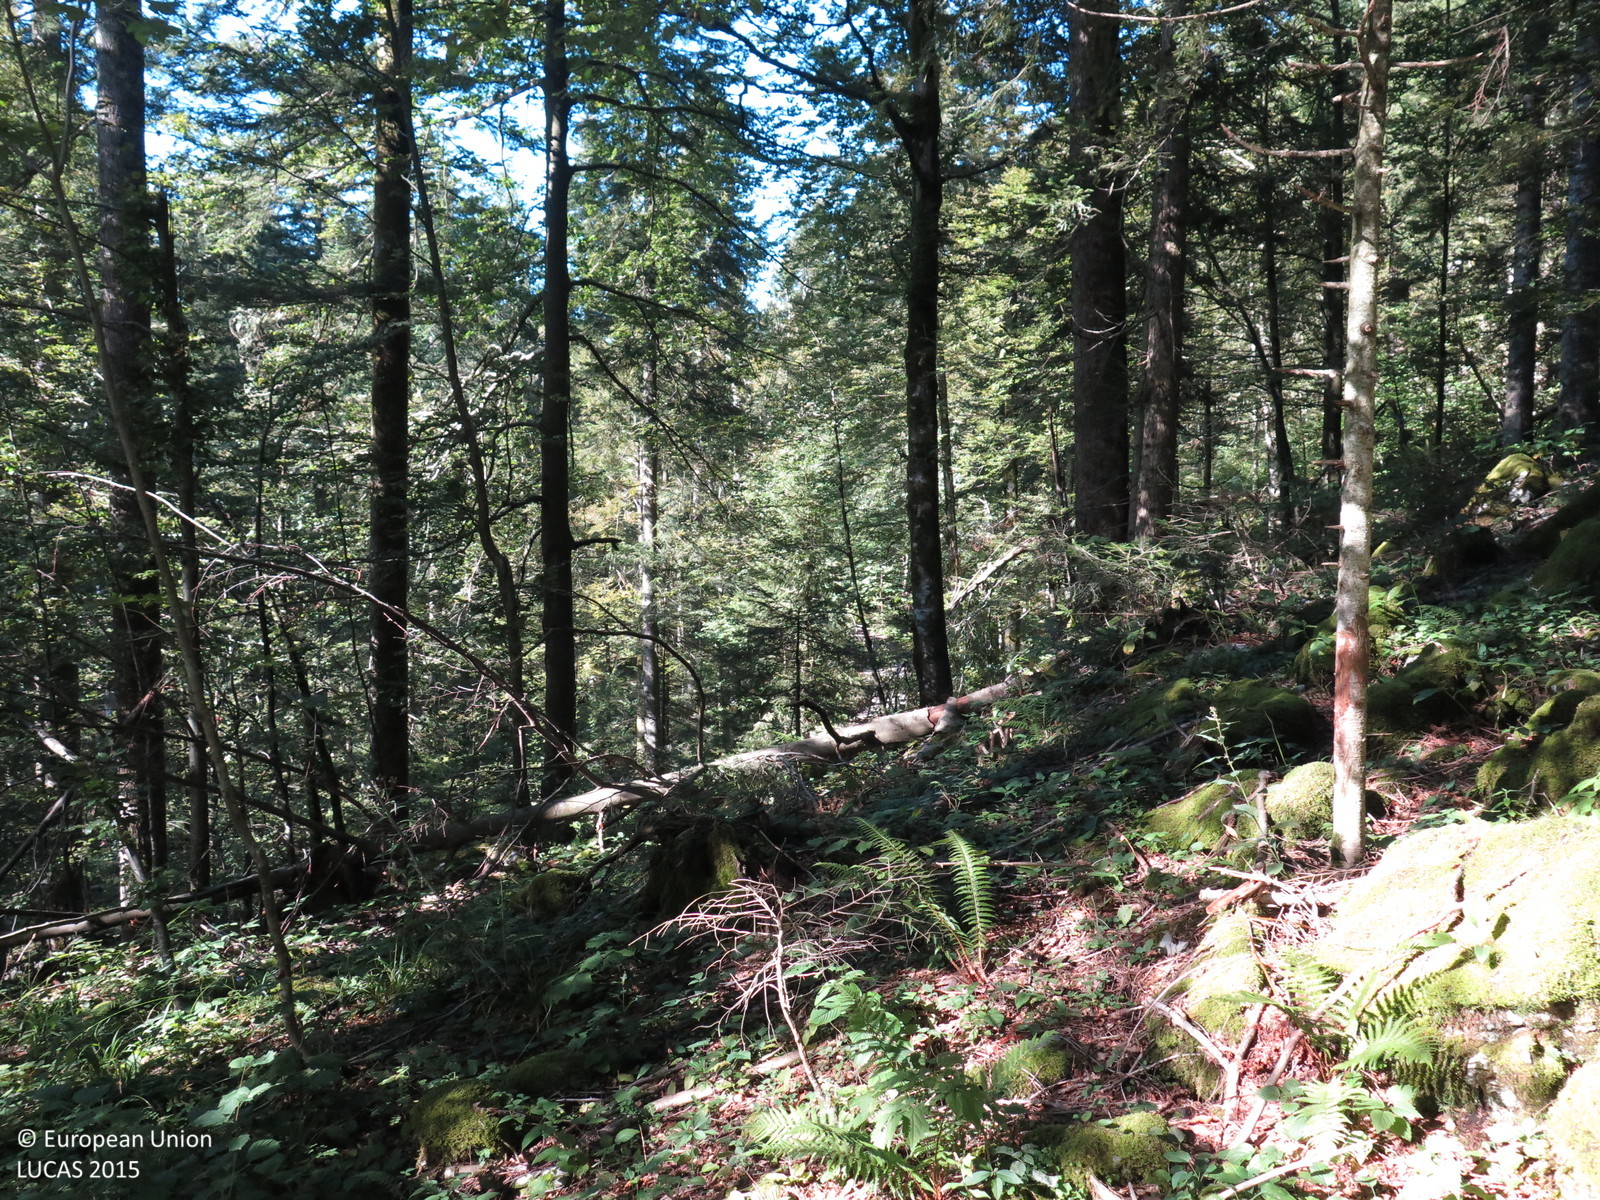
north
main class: Woodland
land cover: Other mixed woodland
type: alpine coniferous forest
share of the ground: > 75 %
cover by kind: coniferous forest trees 75 %, broadleaved forest trees 25 %
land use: Forestry
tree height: > 5 m
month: September
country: HR
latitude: 45.4522
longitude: 14.7393
